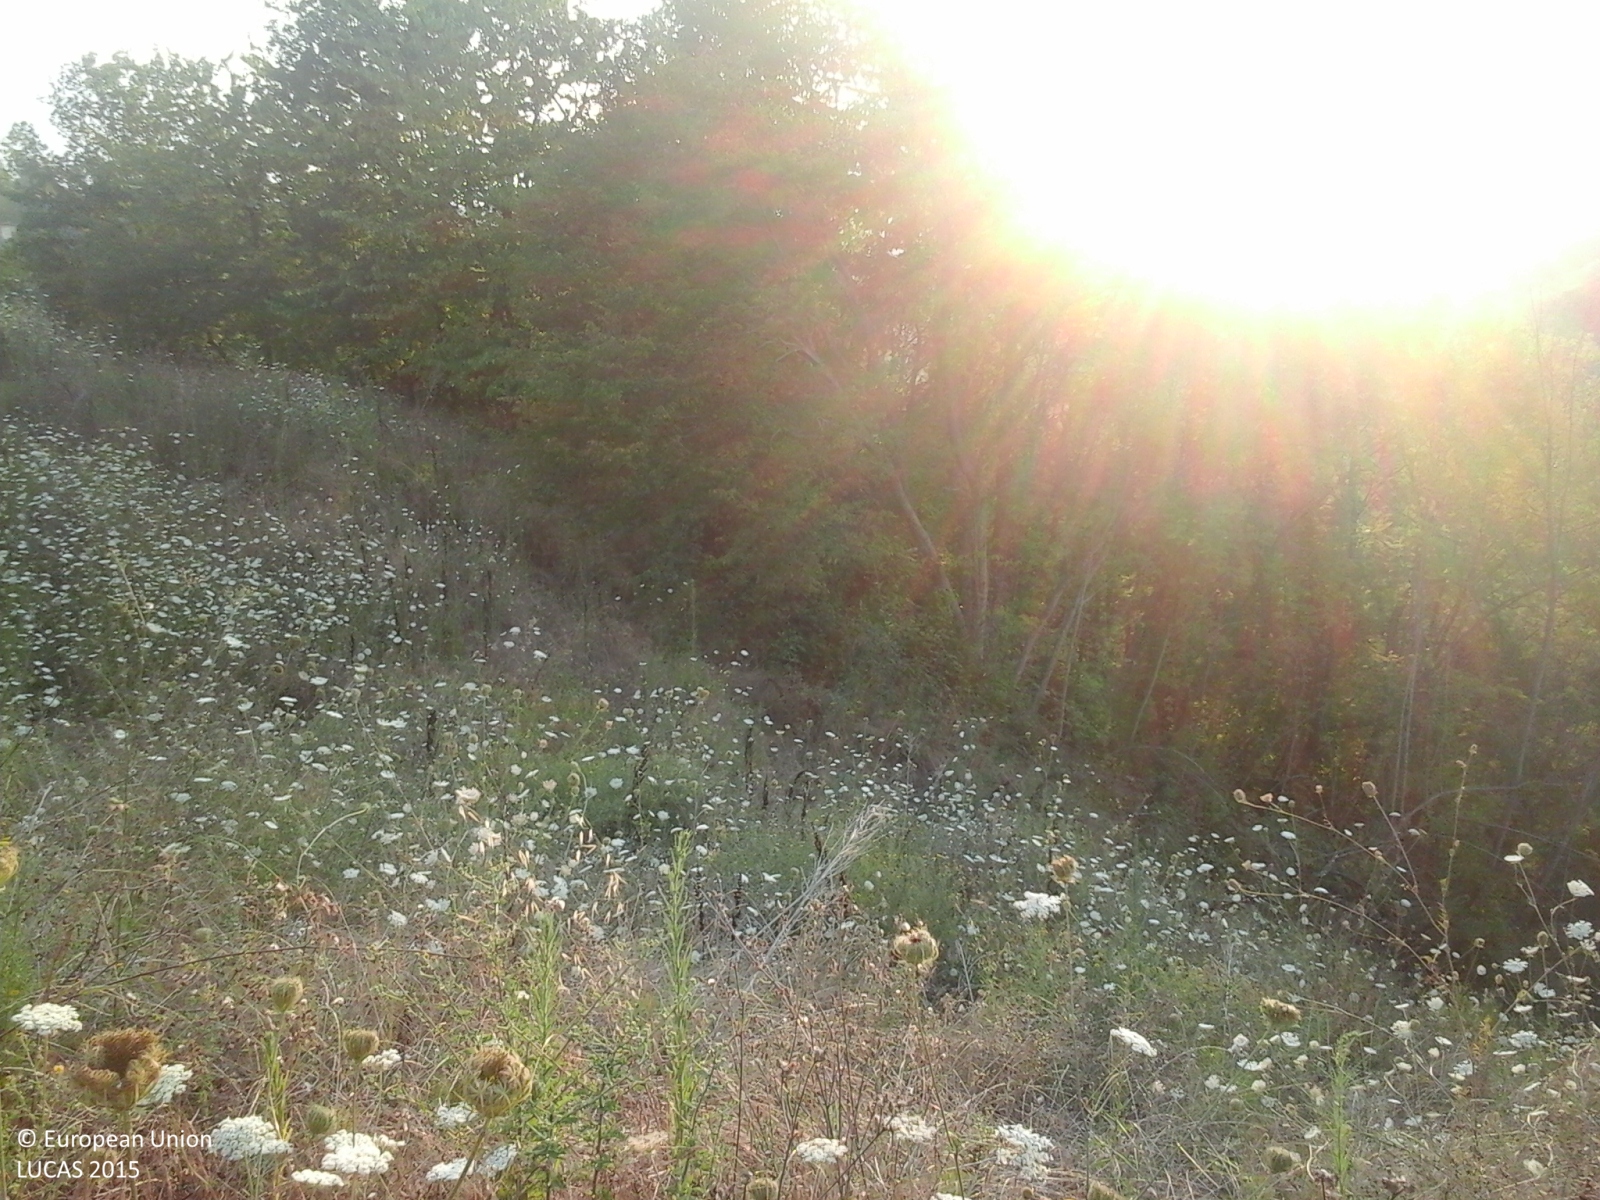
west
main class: Grassland
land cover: Spontaneously vegetated surfaces
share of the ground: > 75 %
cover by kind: herbaceous plants 100 %
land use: Abandoned areas
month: August
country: IT
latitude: 42.4726
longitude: 13.8441
